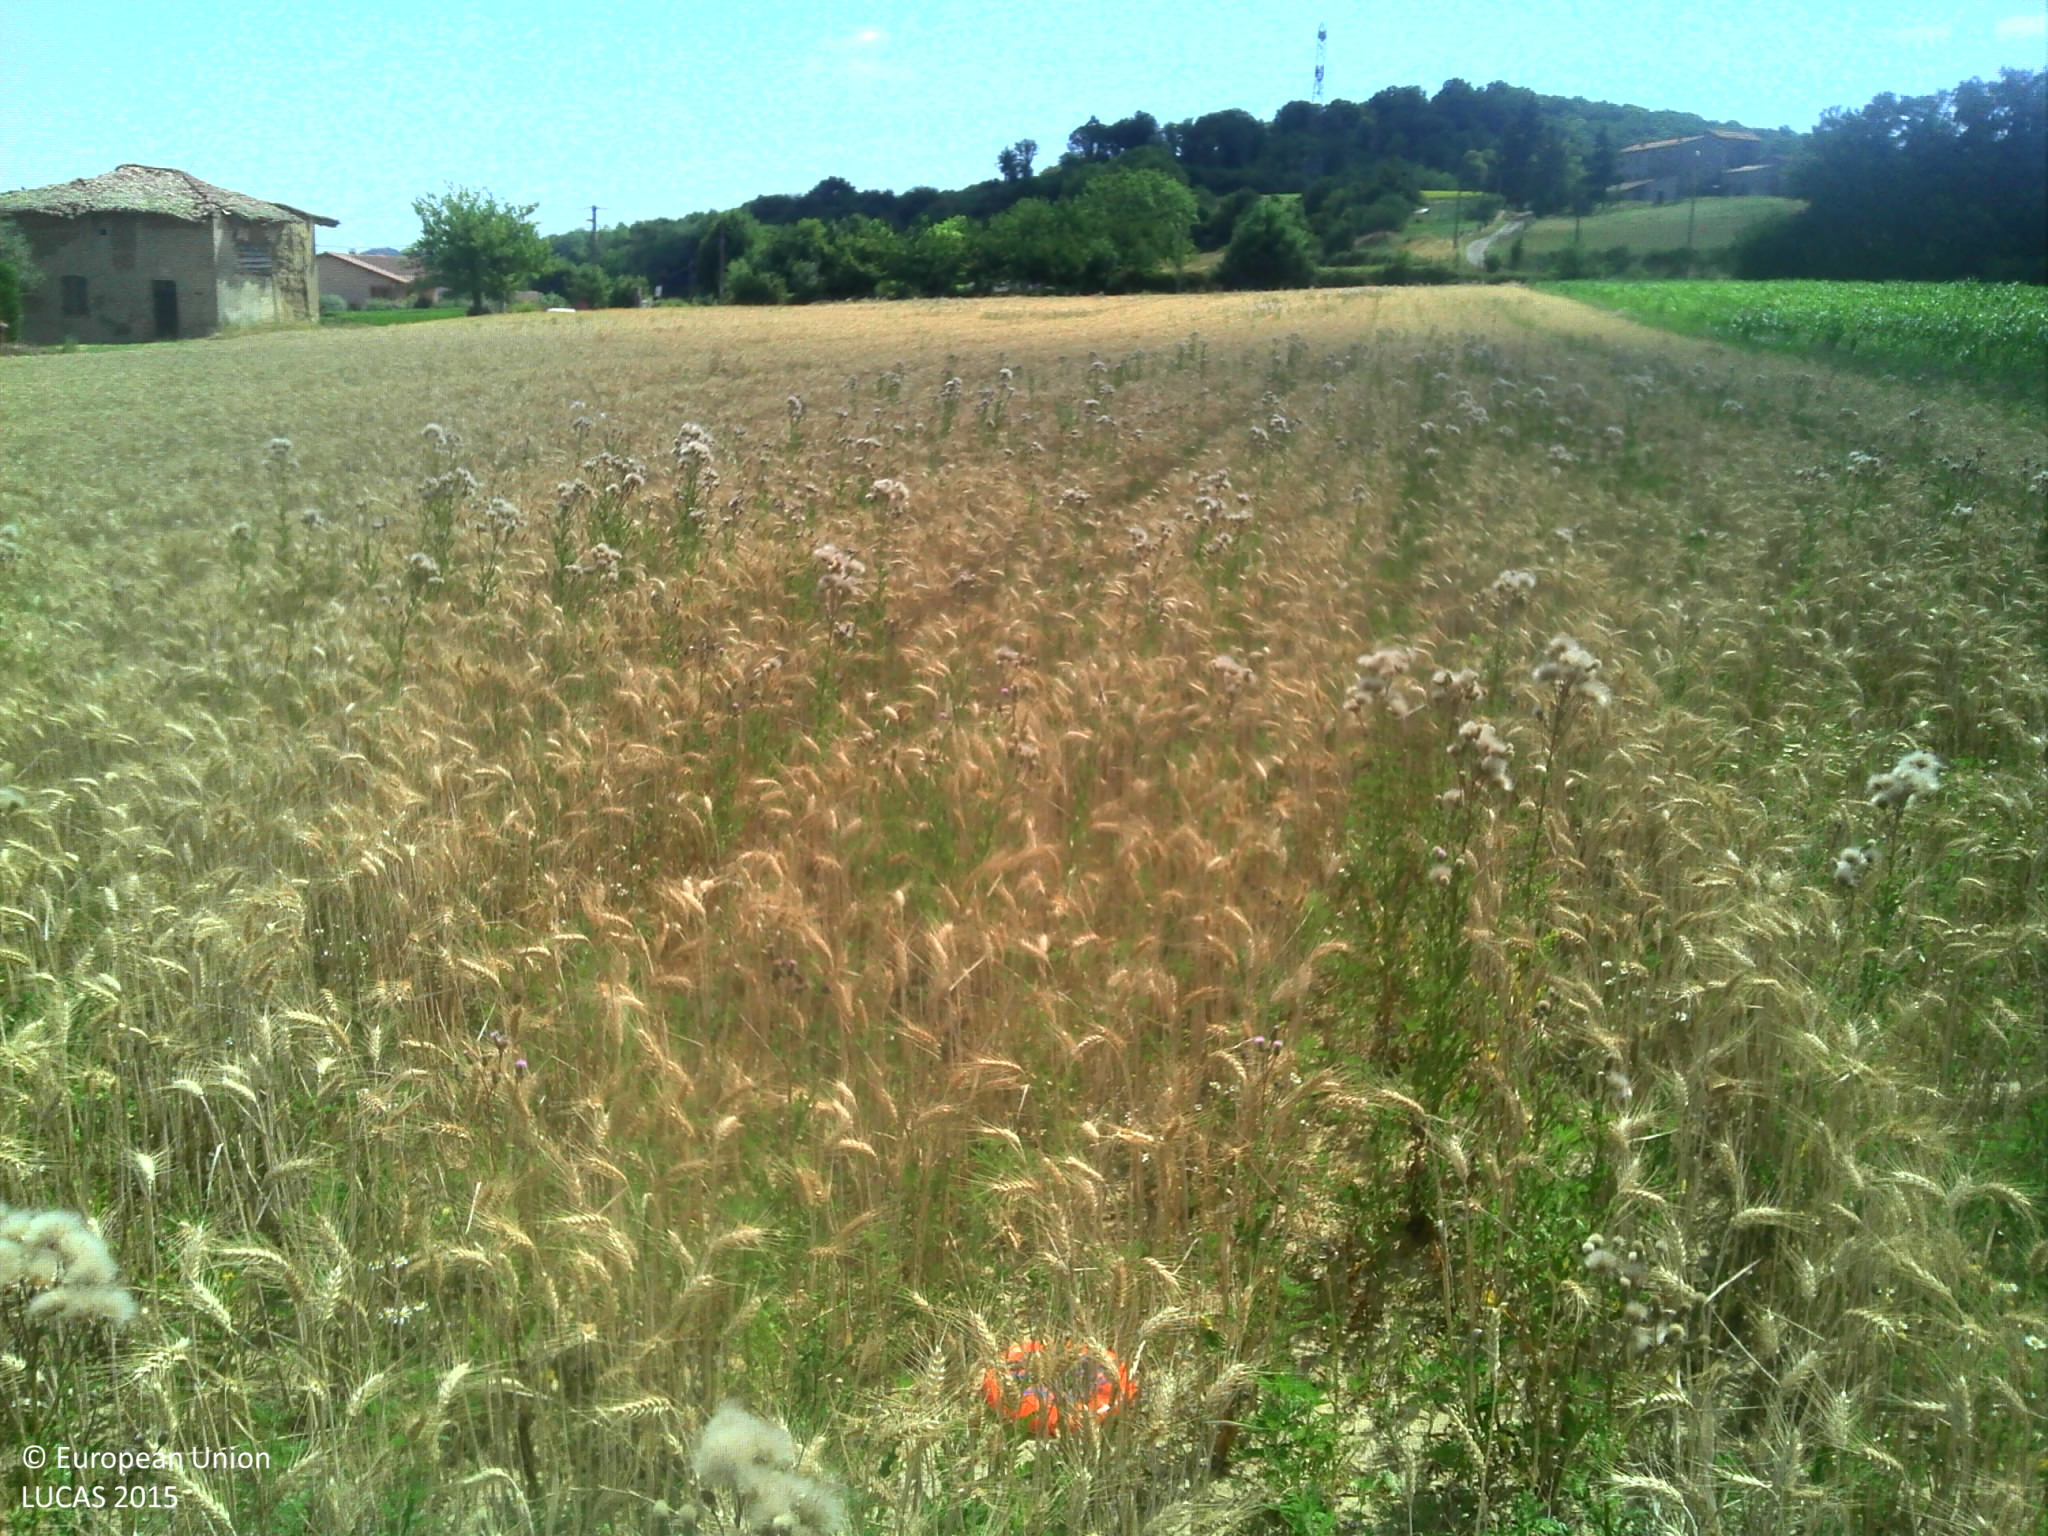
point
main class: Cropland
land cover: Durum wheat
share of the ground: > 75 %
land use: Agriculture (excluding fallow land and kitchen gardens)
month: July
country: FR
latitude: 45.5470
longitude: 4.9705
